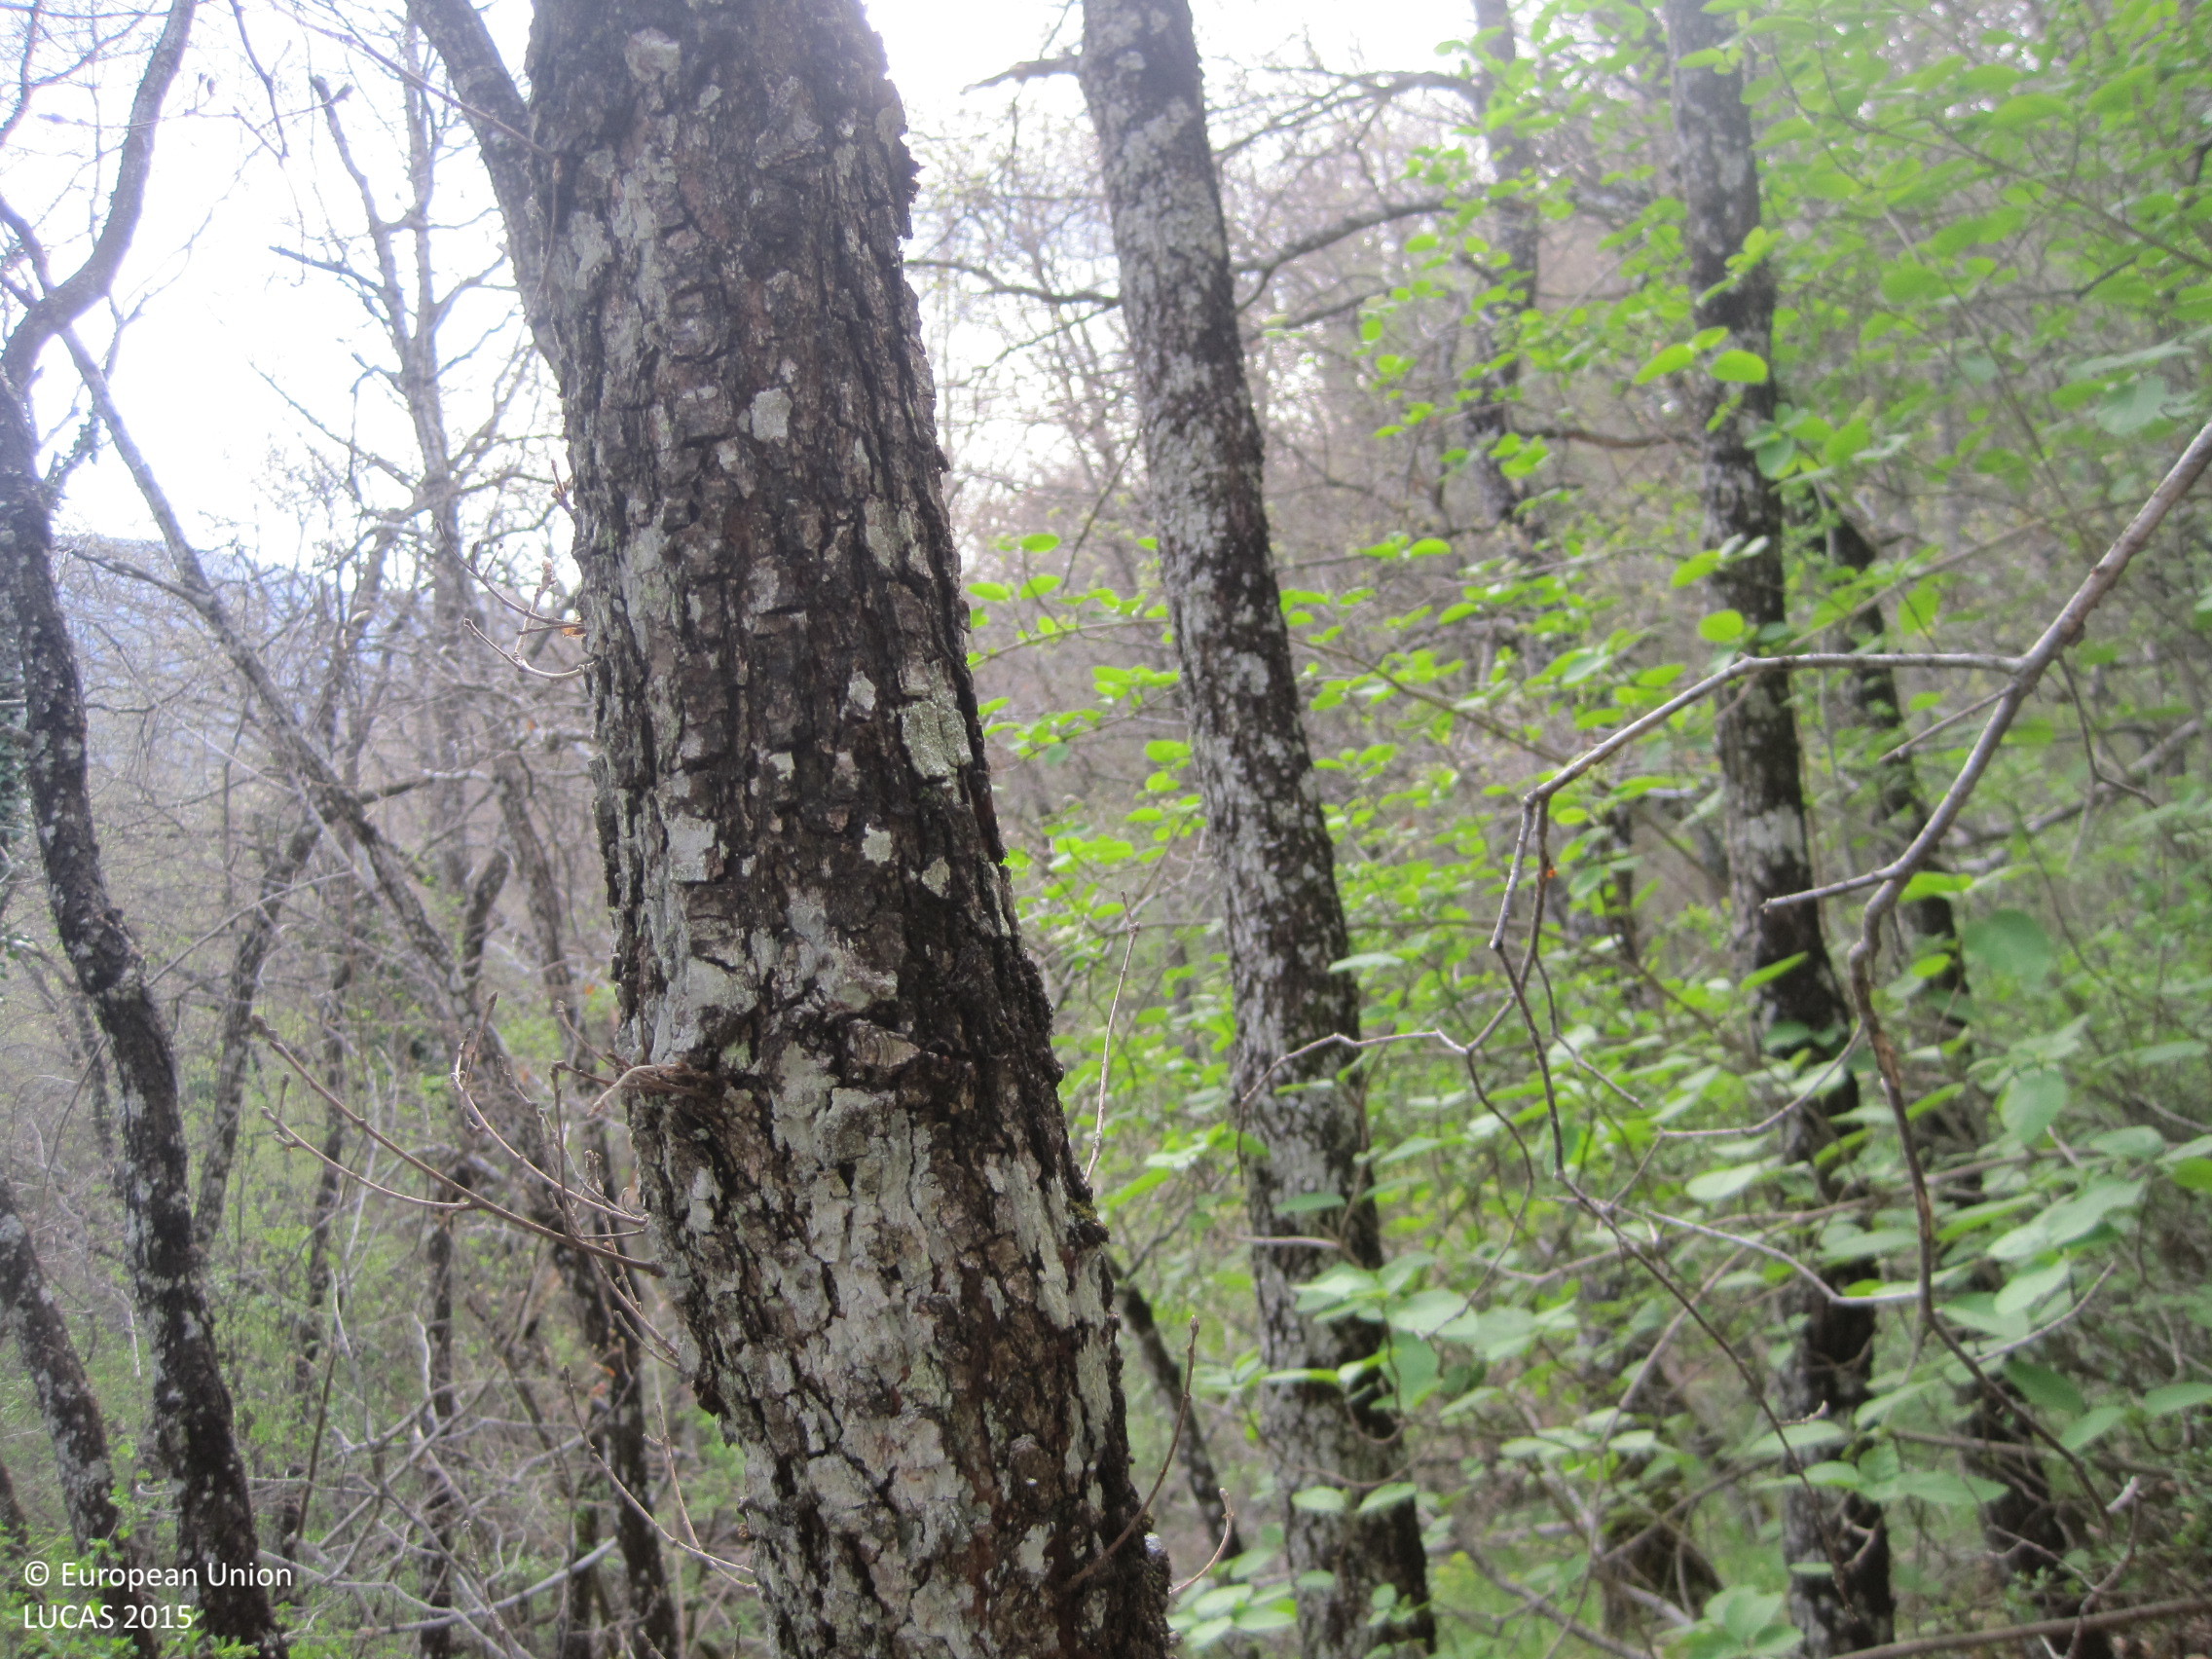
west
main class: Woodland
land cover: Broadleaved woodland
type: acidophilous oak and oak-birch forest
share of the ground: > 75 %
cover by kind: broadleaved forest trees 100 %
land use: Forestry
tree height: > 5 m
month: April
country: ES
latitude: 42.7732
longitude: -2.1809
